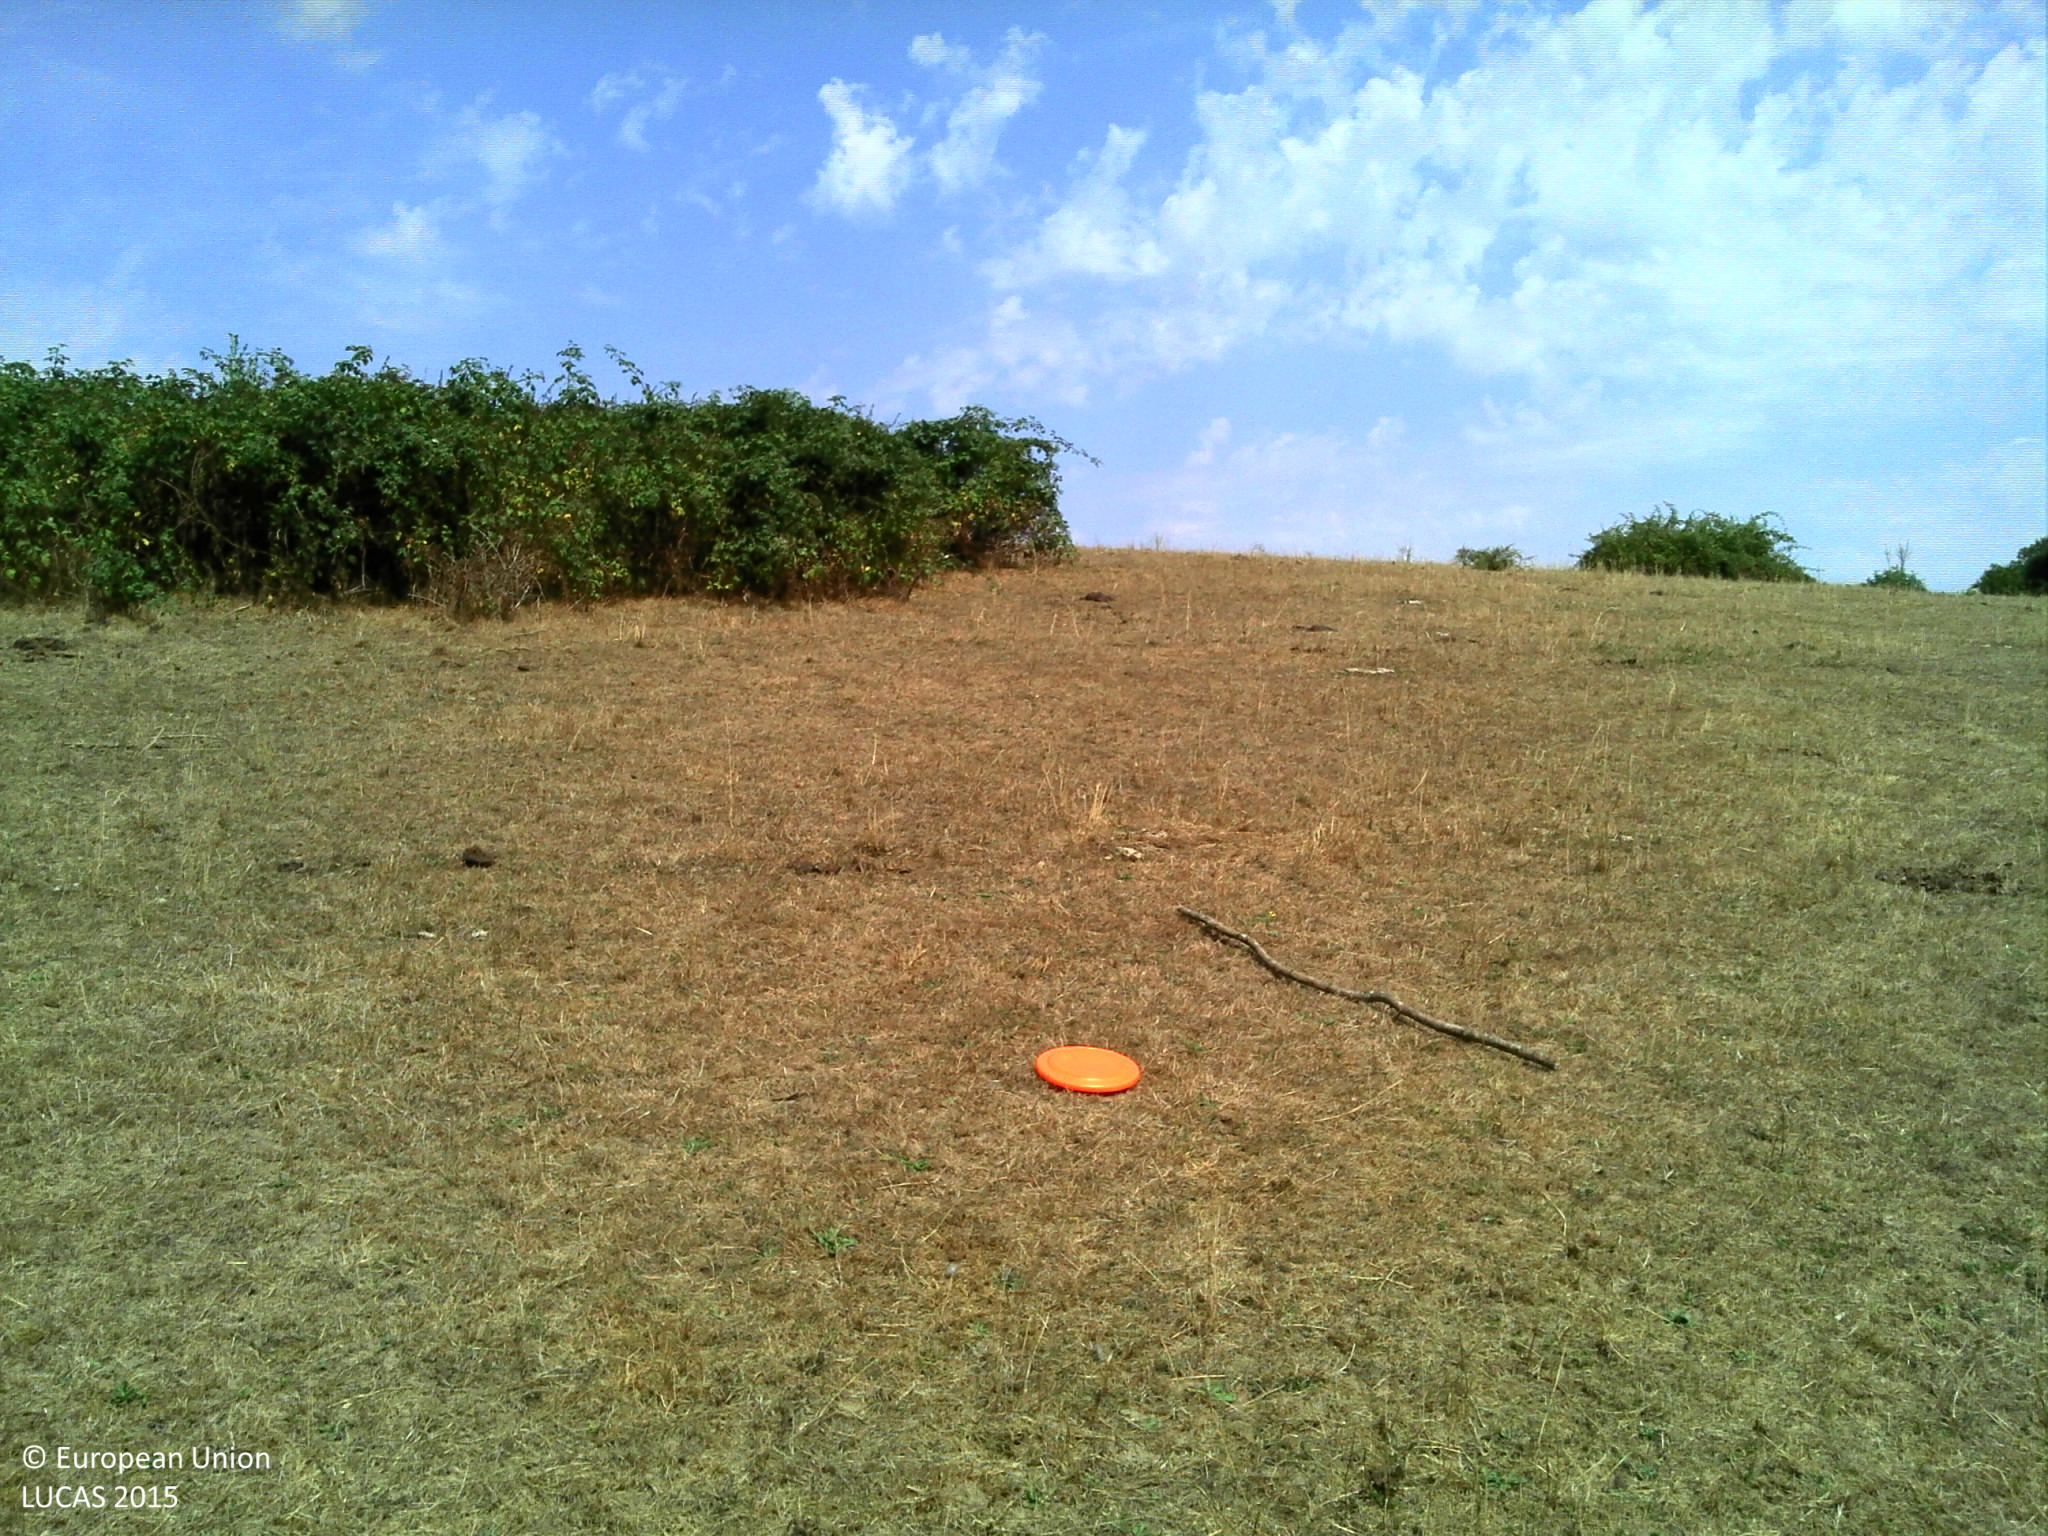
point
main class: Grassland
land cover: Grassland without tree/shrub cover
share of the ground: > 75 %
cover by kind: herbaceous plants 95 %, shrubs 5 %
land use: Agriculture (excluding fallow land and kitchen gardens)
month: August
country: FR
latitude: 47.7738
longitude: 3.1216
